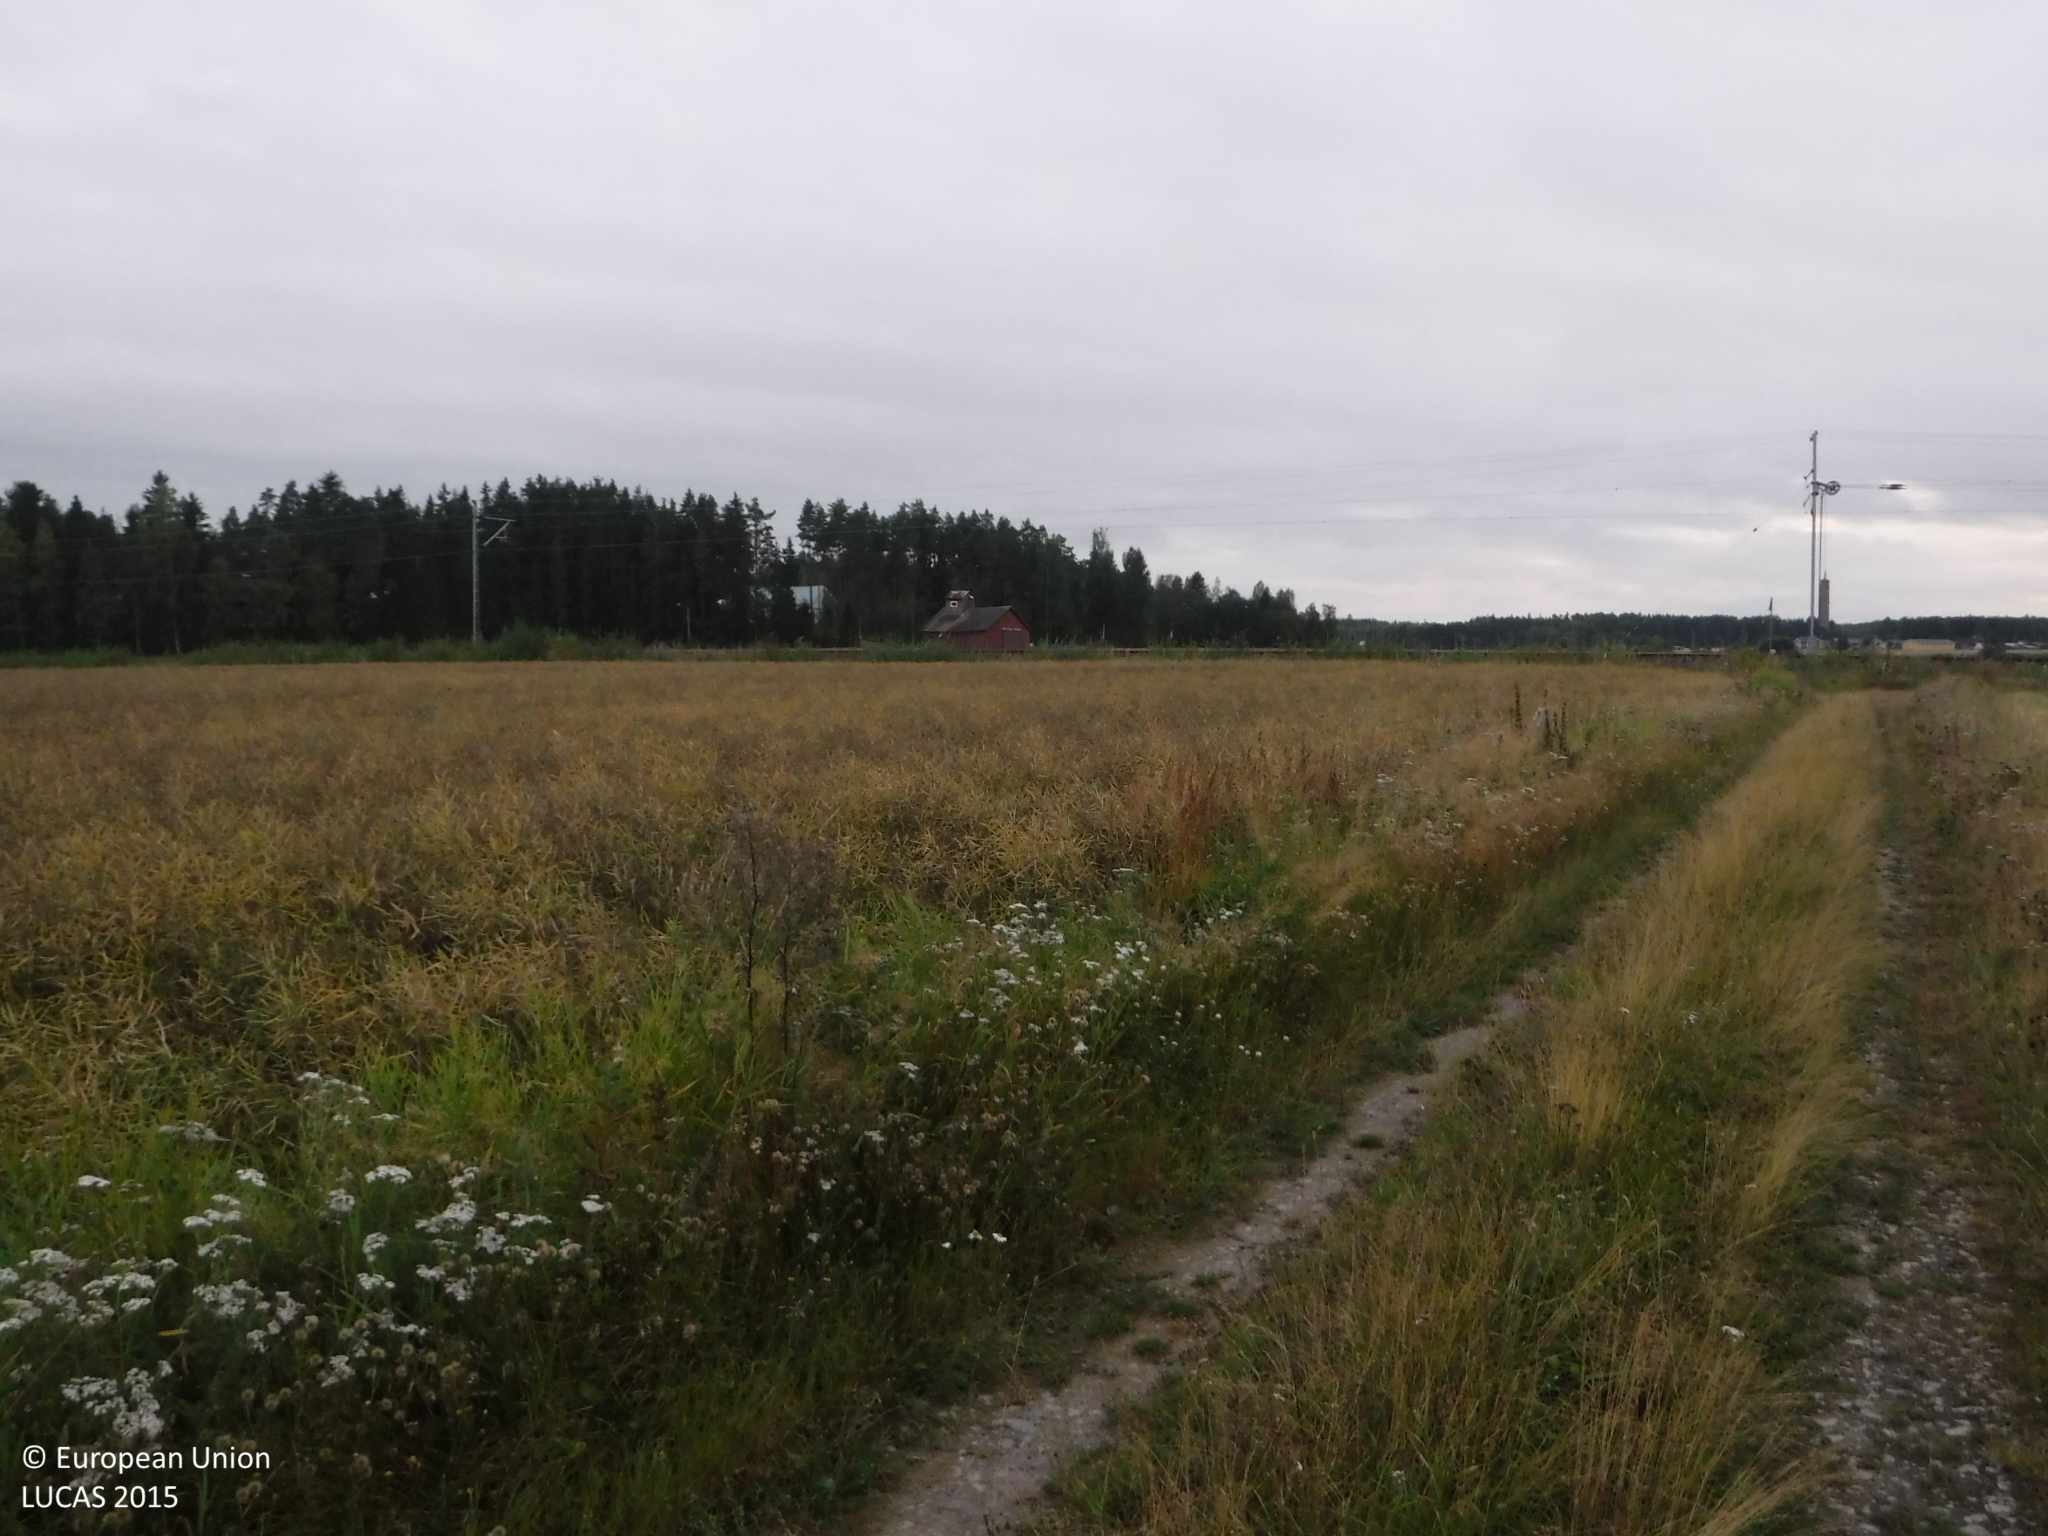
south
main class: Cropland
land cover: Barley
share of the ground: > 75 %
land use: Agriculture (excluding fallow land and kitchen gardens)
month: September
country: FI
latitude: 61.3833
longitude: 21.9796
